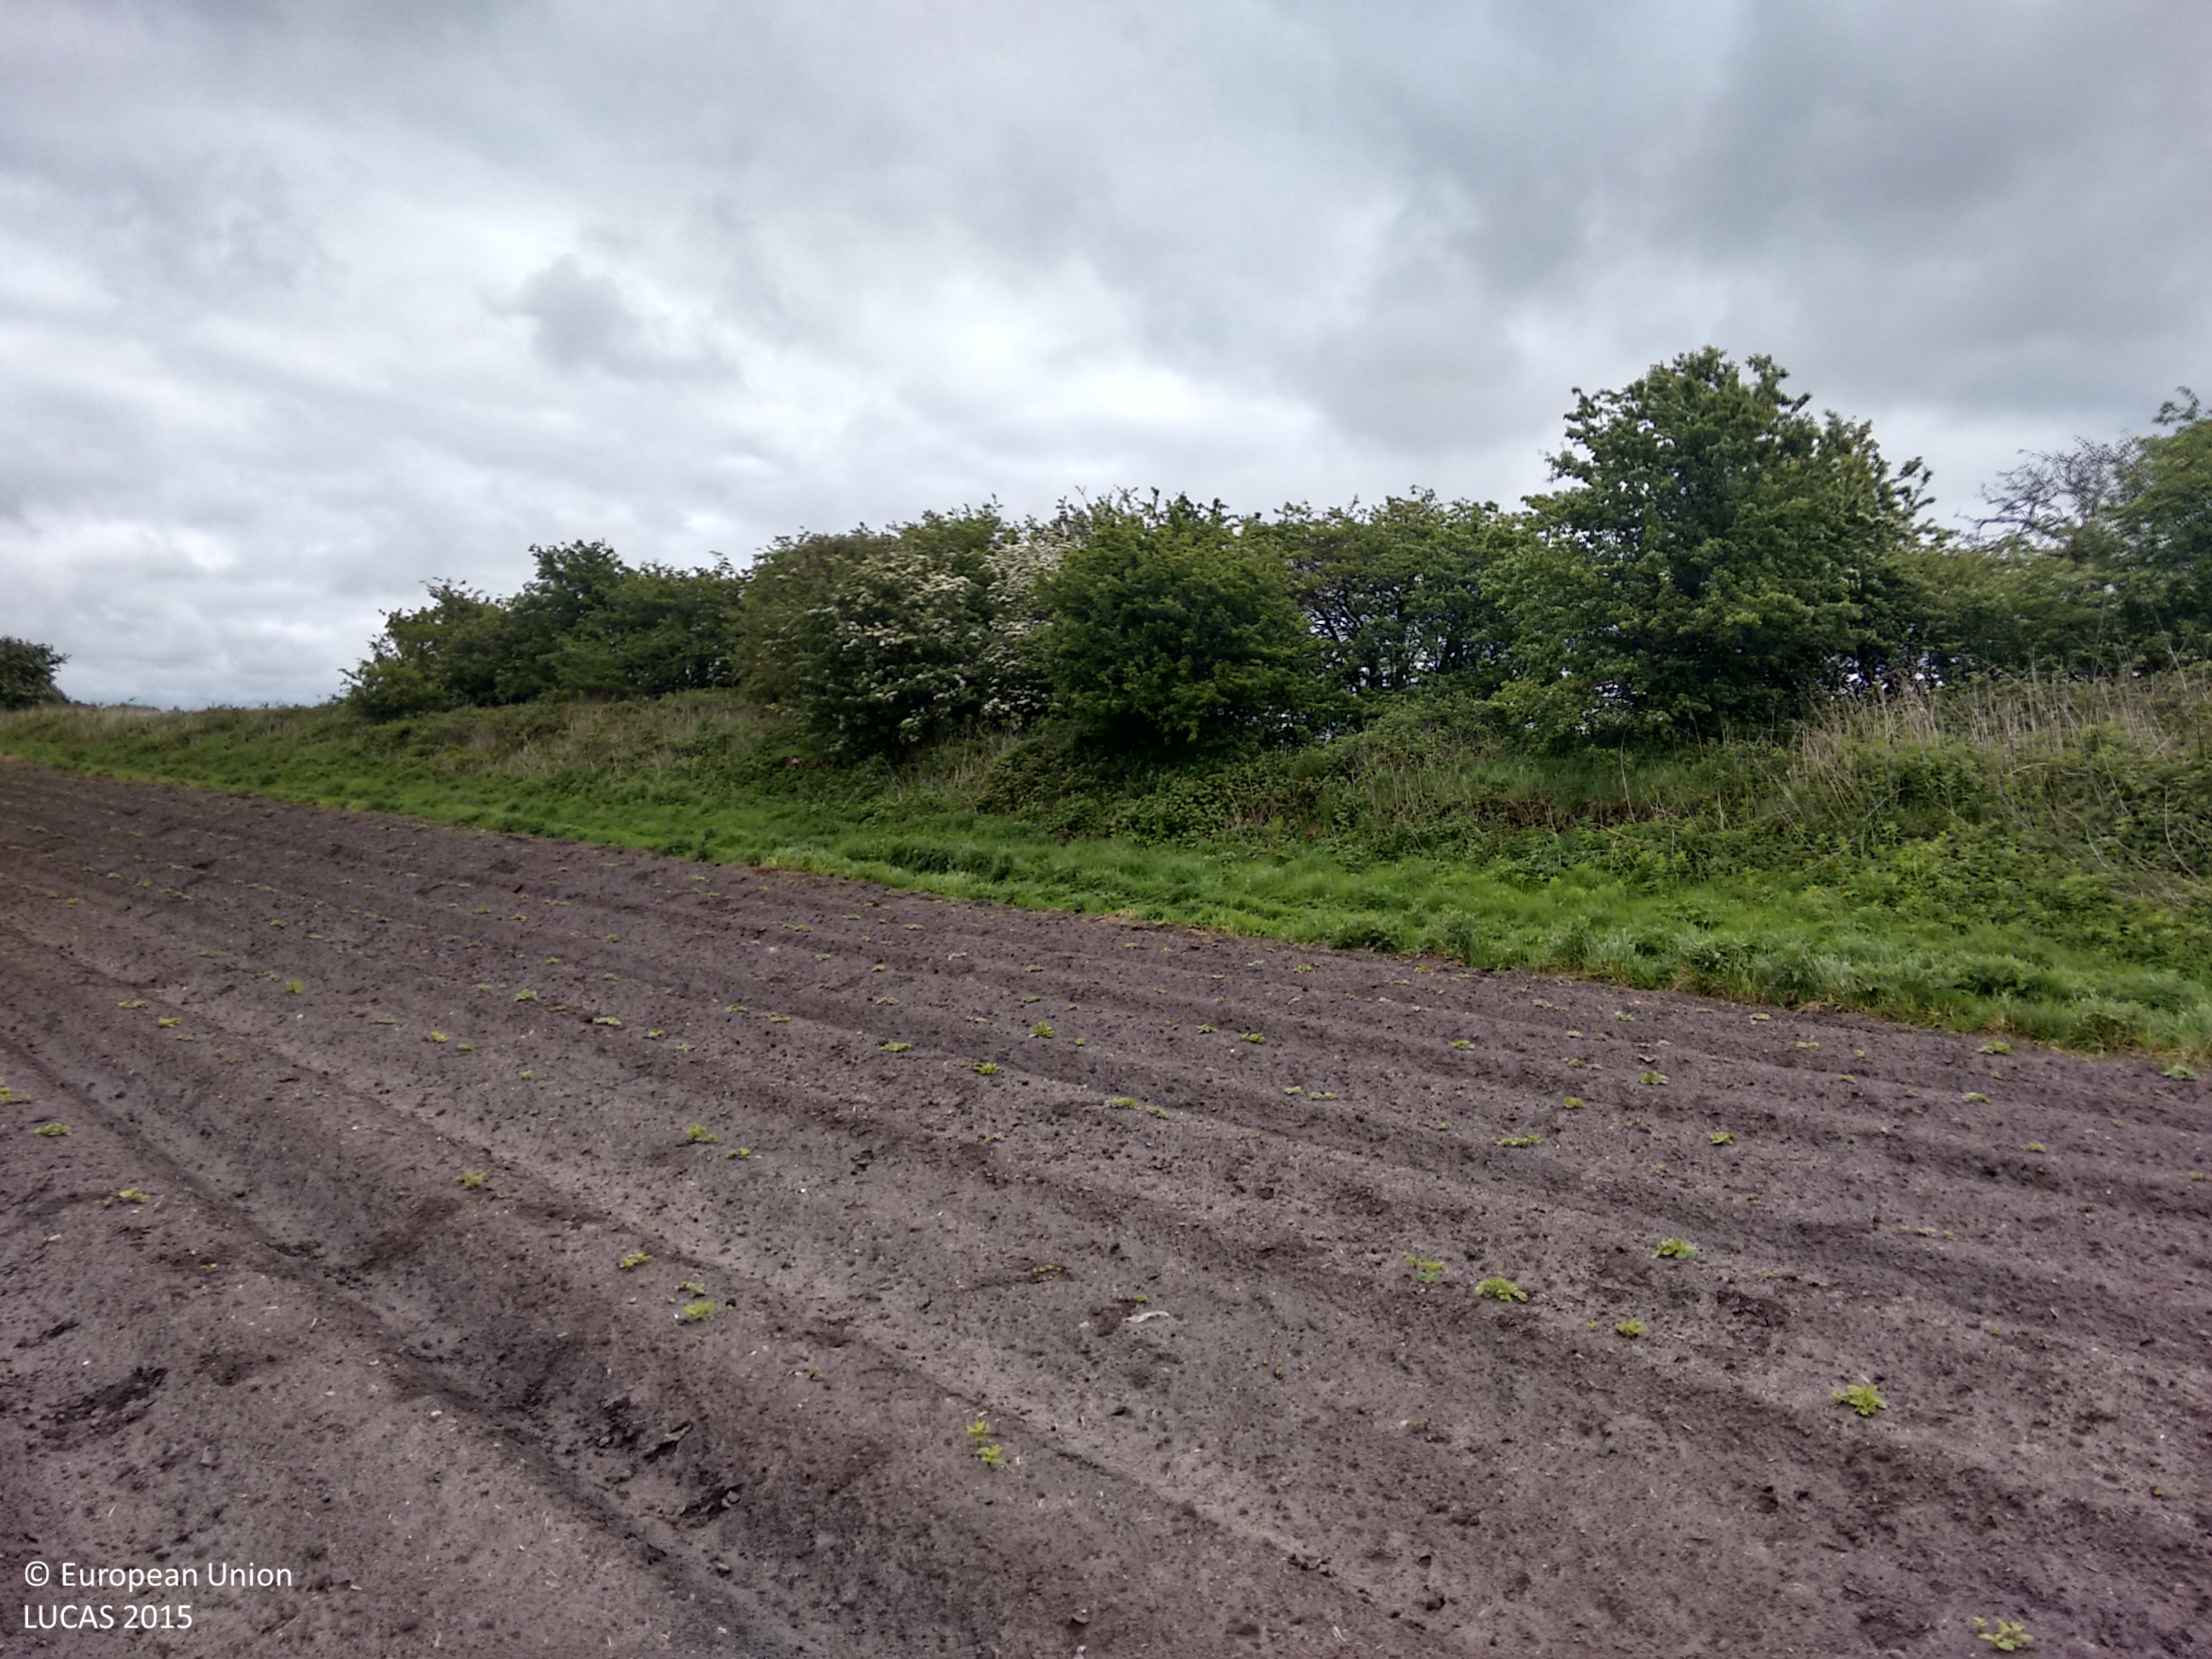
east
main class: Cropland
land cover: Potatoes
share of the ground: < 10 %
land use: Agriculture (excluding fallow land and kitchen gardens)
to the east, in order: Potatoes; Grass margins; Tracks; Abandoned hedges; Fences; Abandoned hedges; Barley
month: May
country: GB
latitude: 53.5366
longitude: -2.8207
